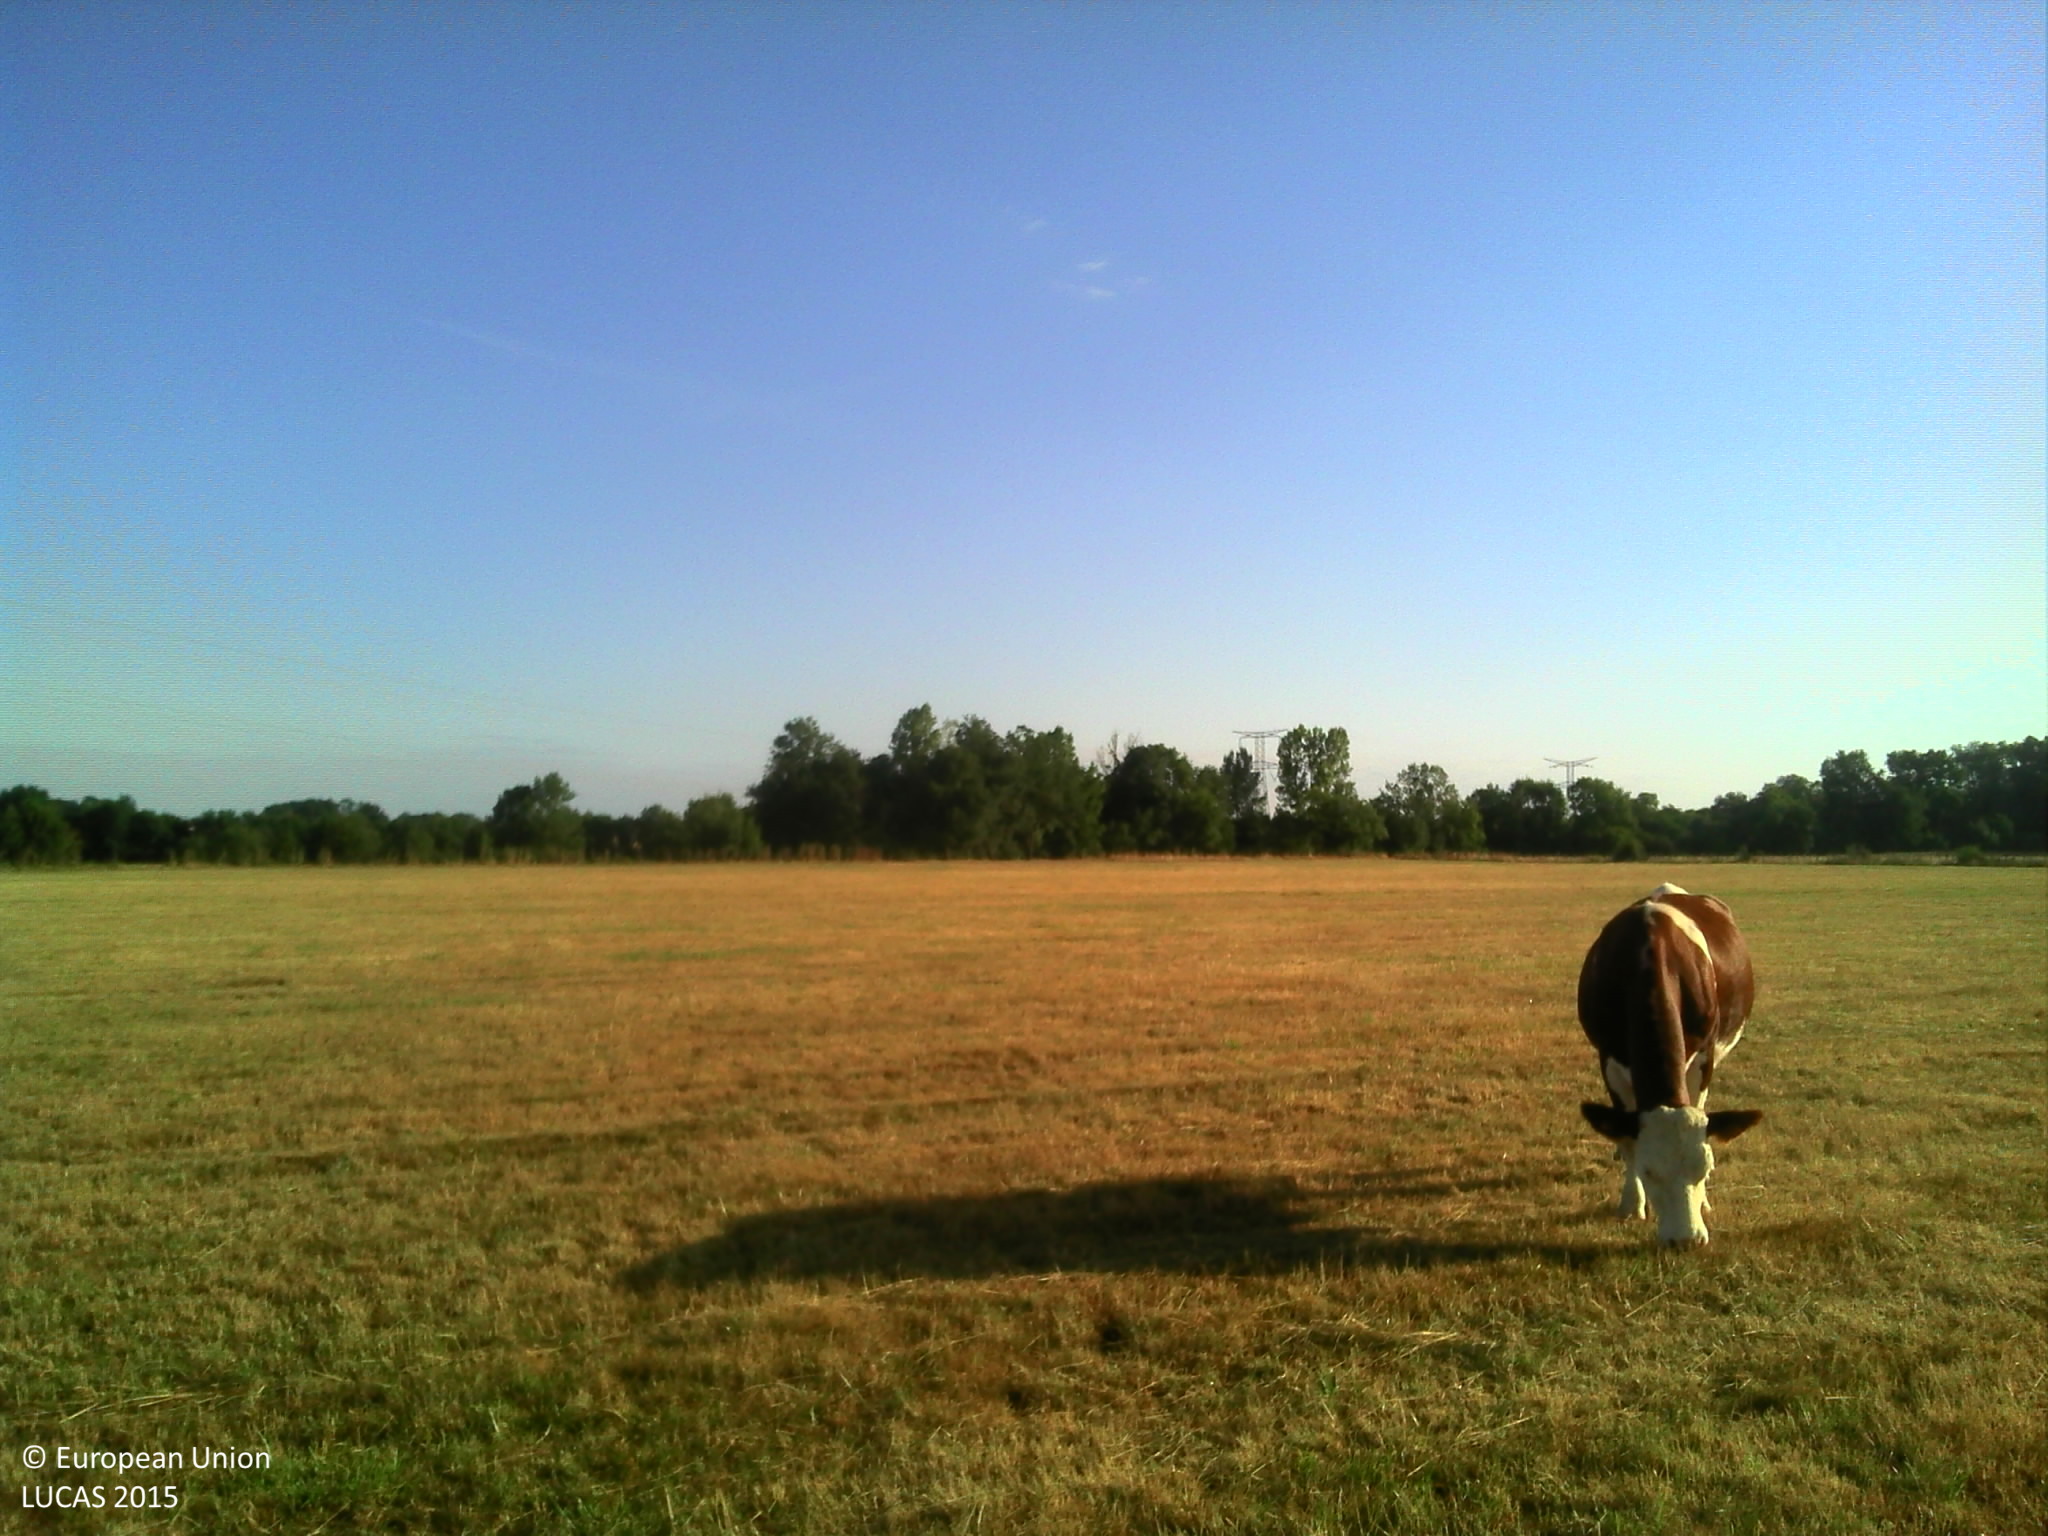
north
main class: Grassland
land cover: Grassland without tree/shrub cover
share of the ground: > 75 %
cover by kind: herbaceous plants 100 %
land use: Agriculture (excluding fallow land and kitchen gardens)
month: July
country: FR
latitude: 46.6790
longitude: 4.8638
